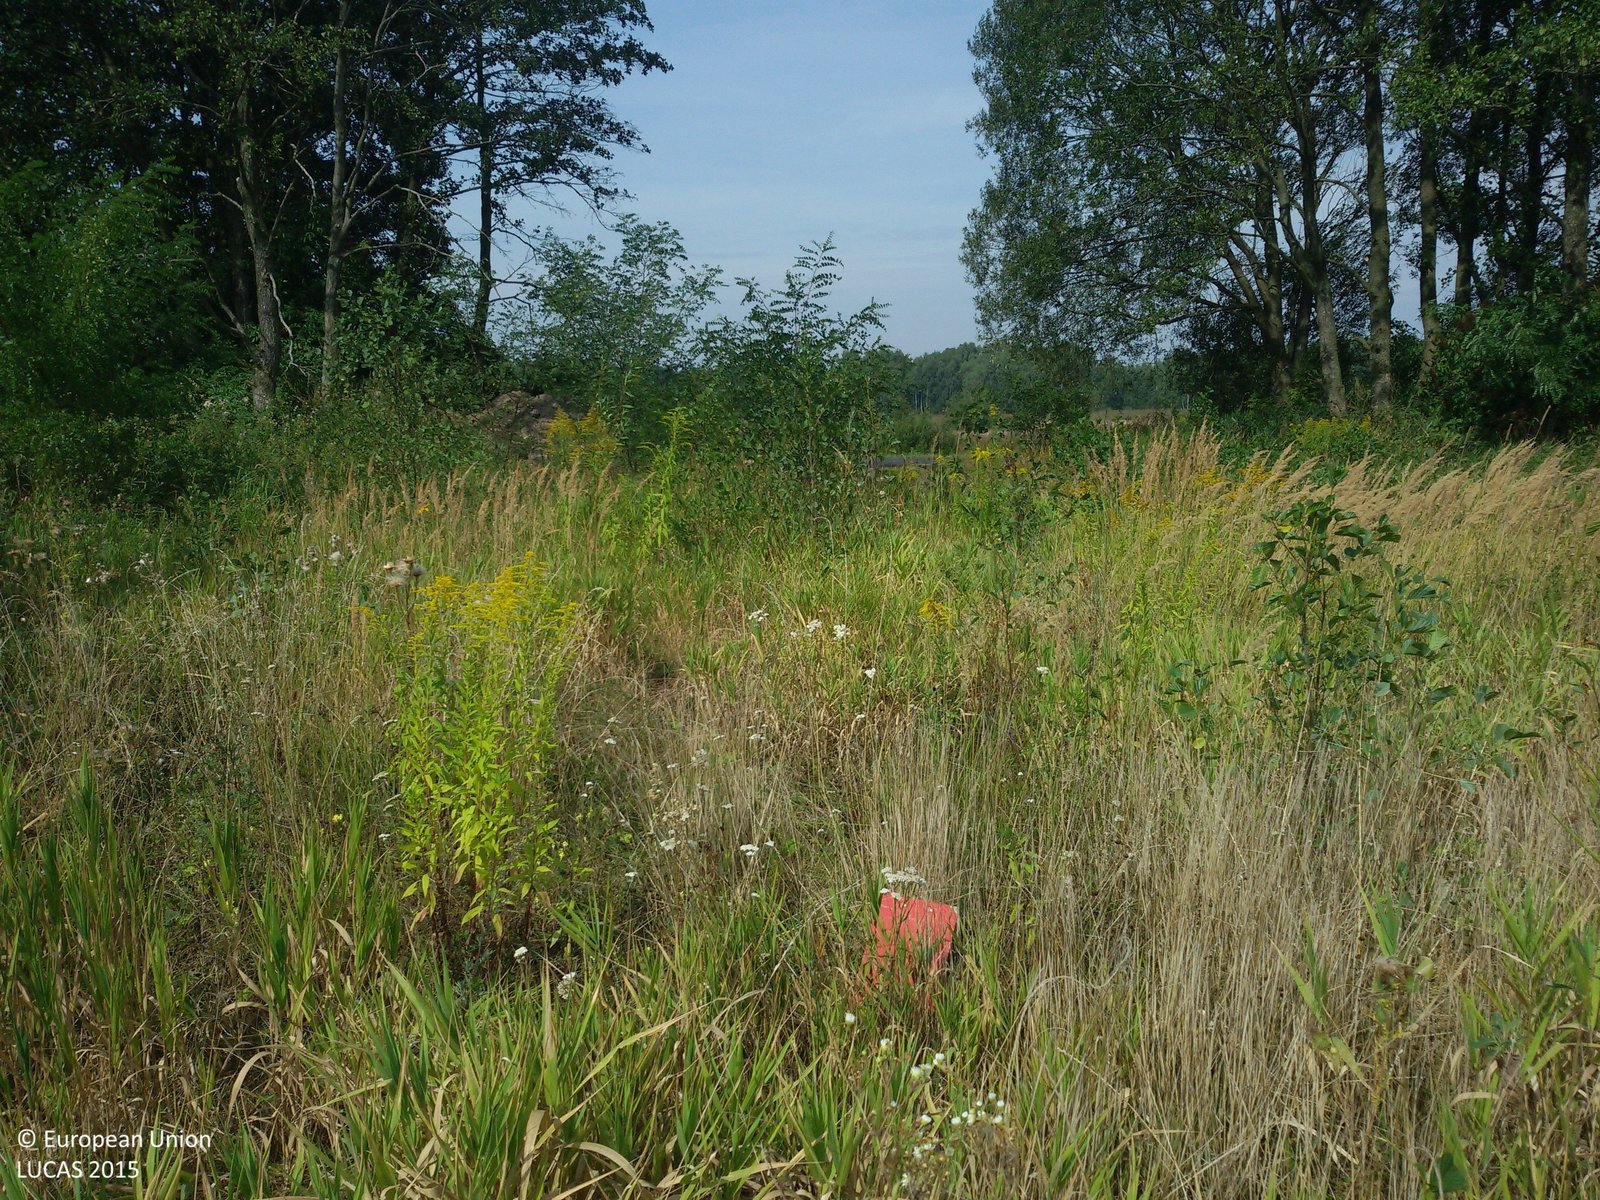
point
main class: Grassland
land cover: Grassland with sparse tree/shrub cover
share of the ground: > 75 %
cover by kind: herbaceous plants 95 %, broadleaved forest trees 5 %
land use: Abandoned areas
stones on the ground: < 10 %
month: August
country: PL
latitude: 51.4327
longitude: 19.7396
